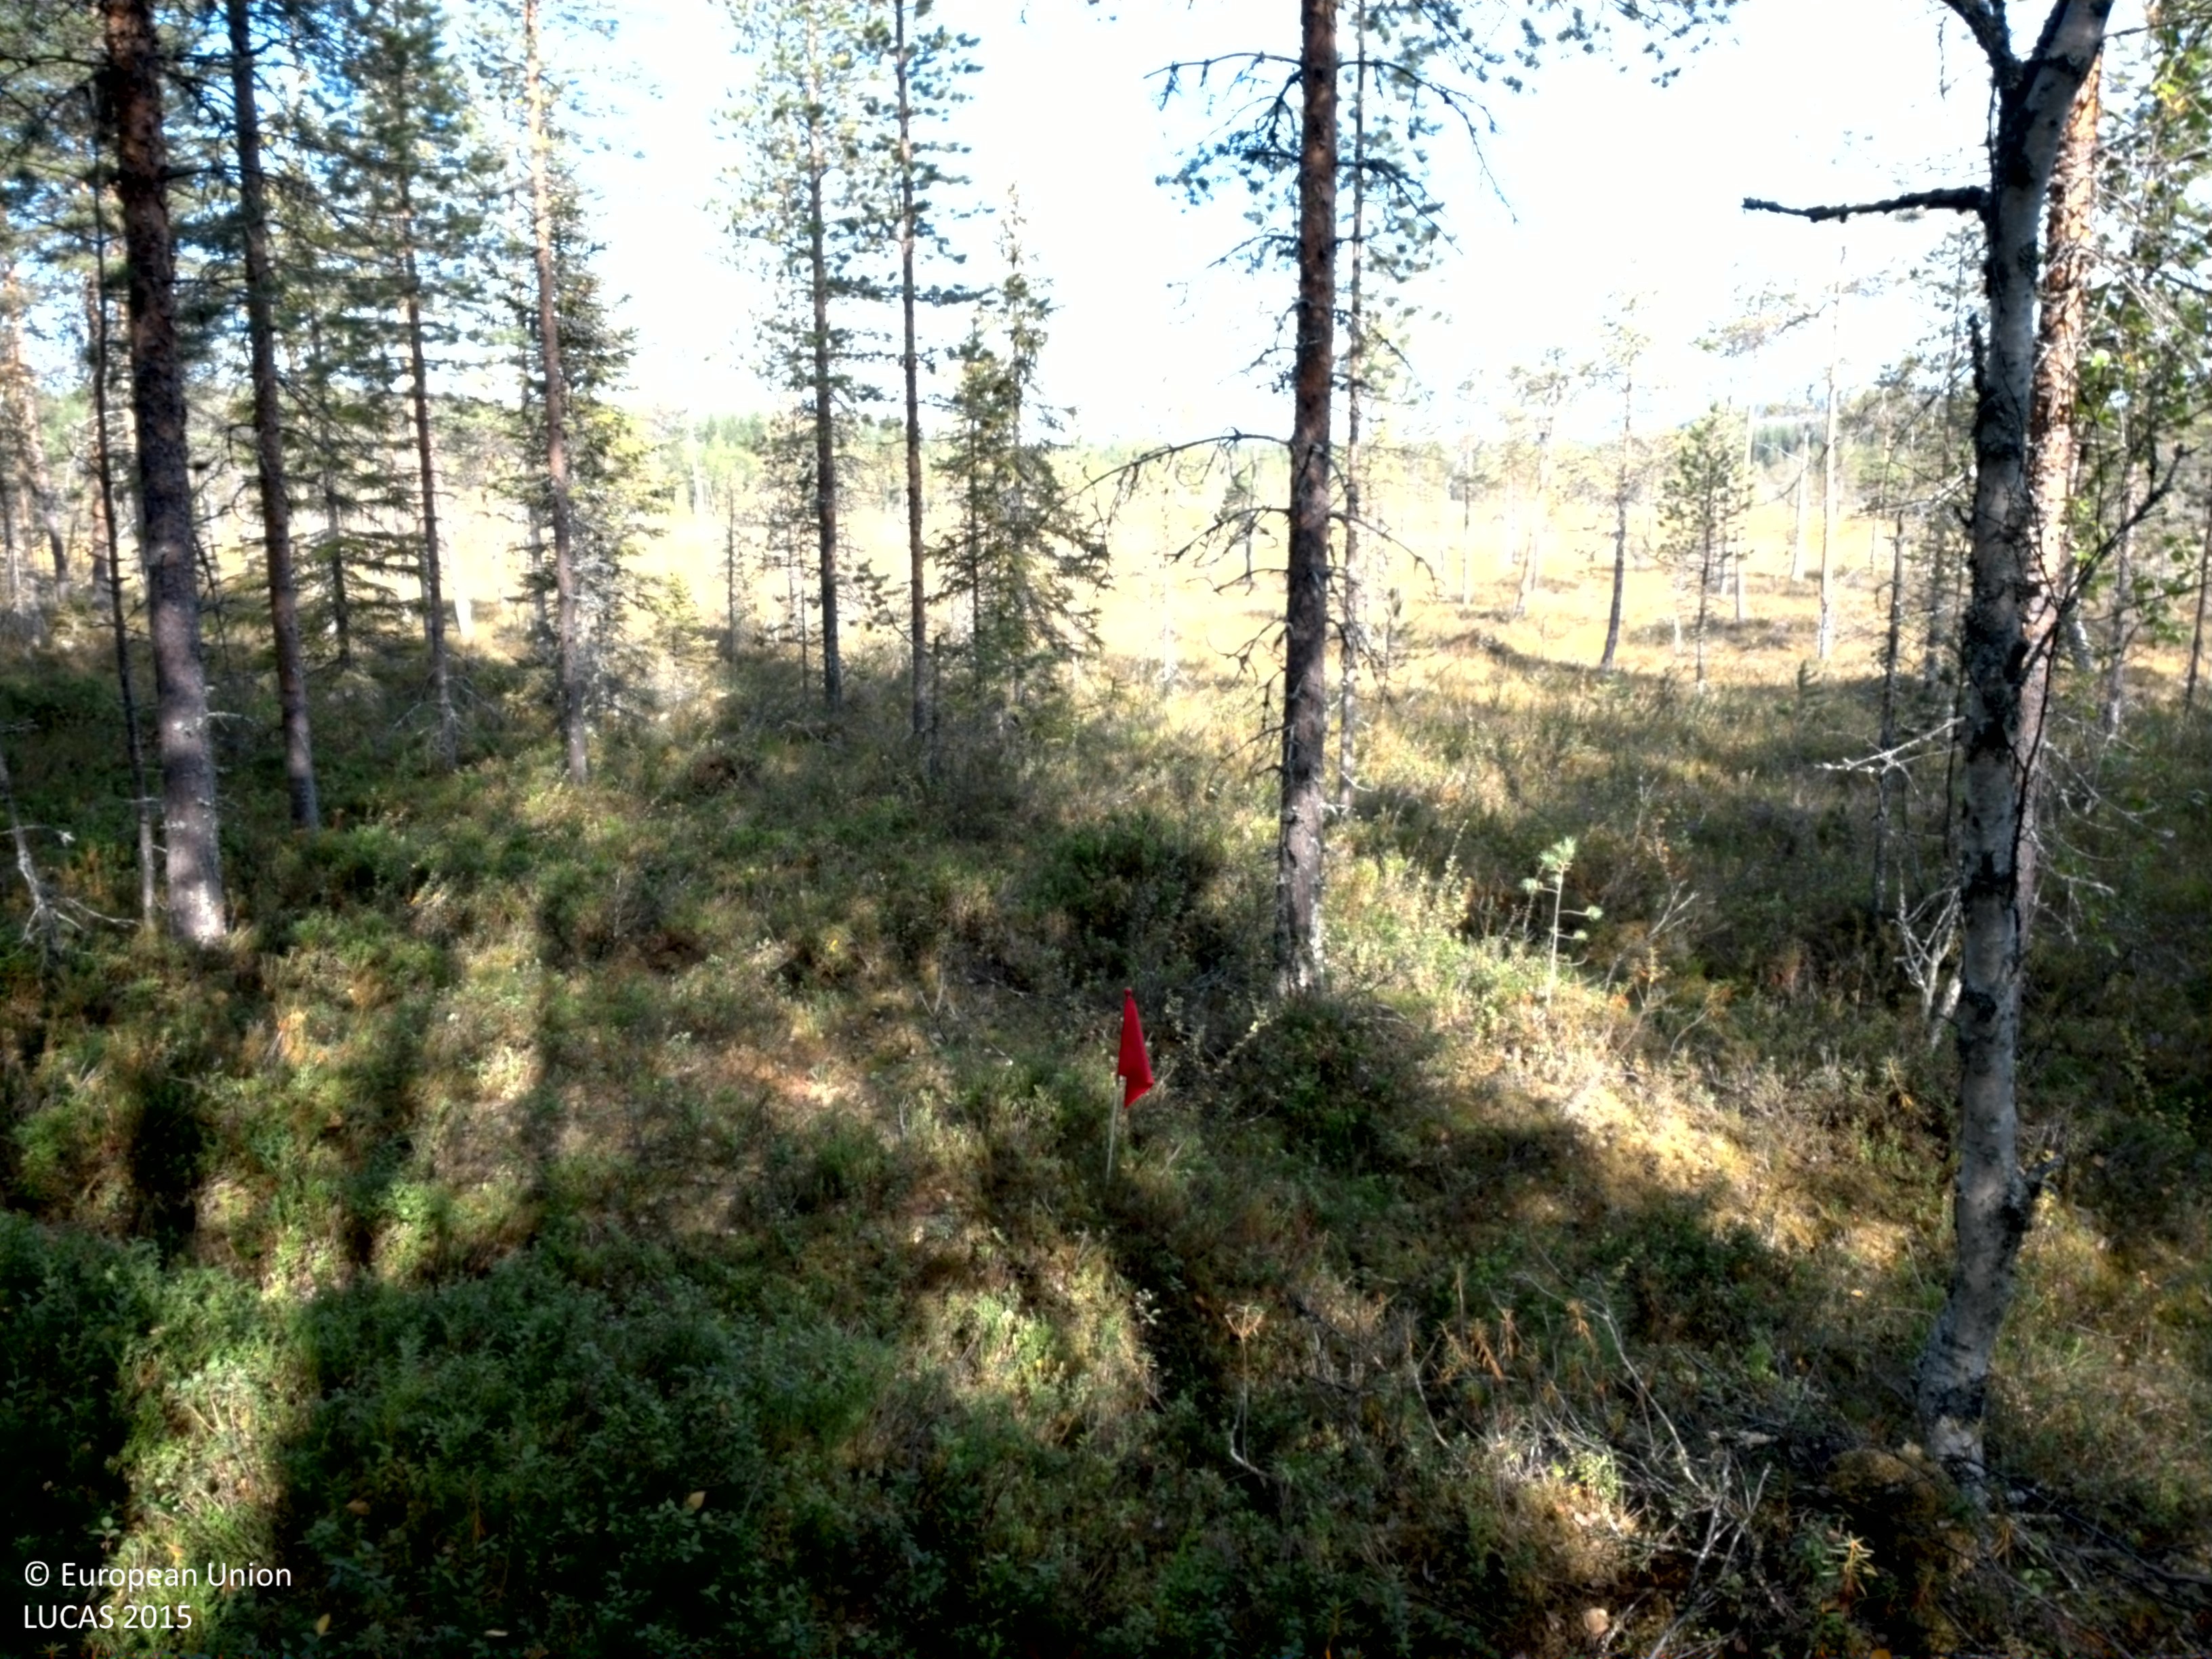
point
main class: Woodland
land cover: Pine dominated mixed woodland
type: boreal forest
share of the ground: 50 - 75 %
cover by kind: coniferous forest trees 45 %, shrubs 30 %, broadleaved forest trees 15 %, lichens and mosses 10 %
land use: Forestry
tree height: > 5 m
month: August
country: SE
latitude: 64.6010
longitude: 18.9329
